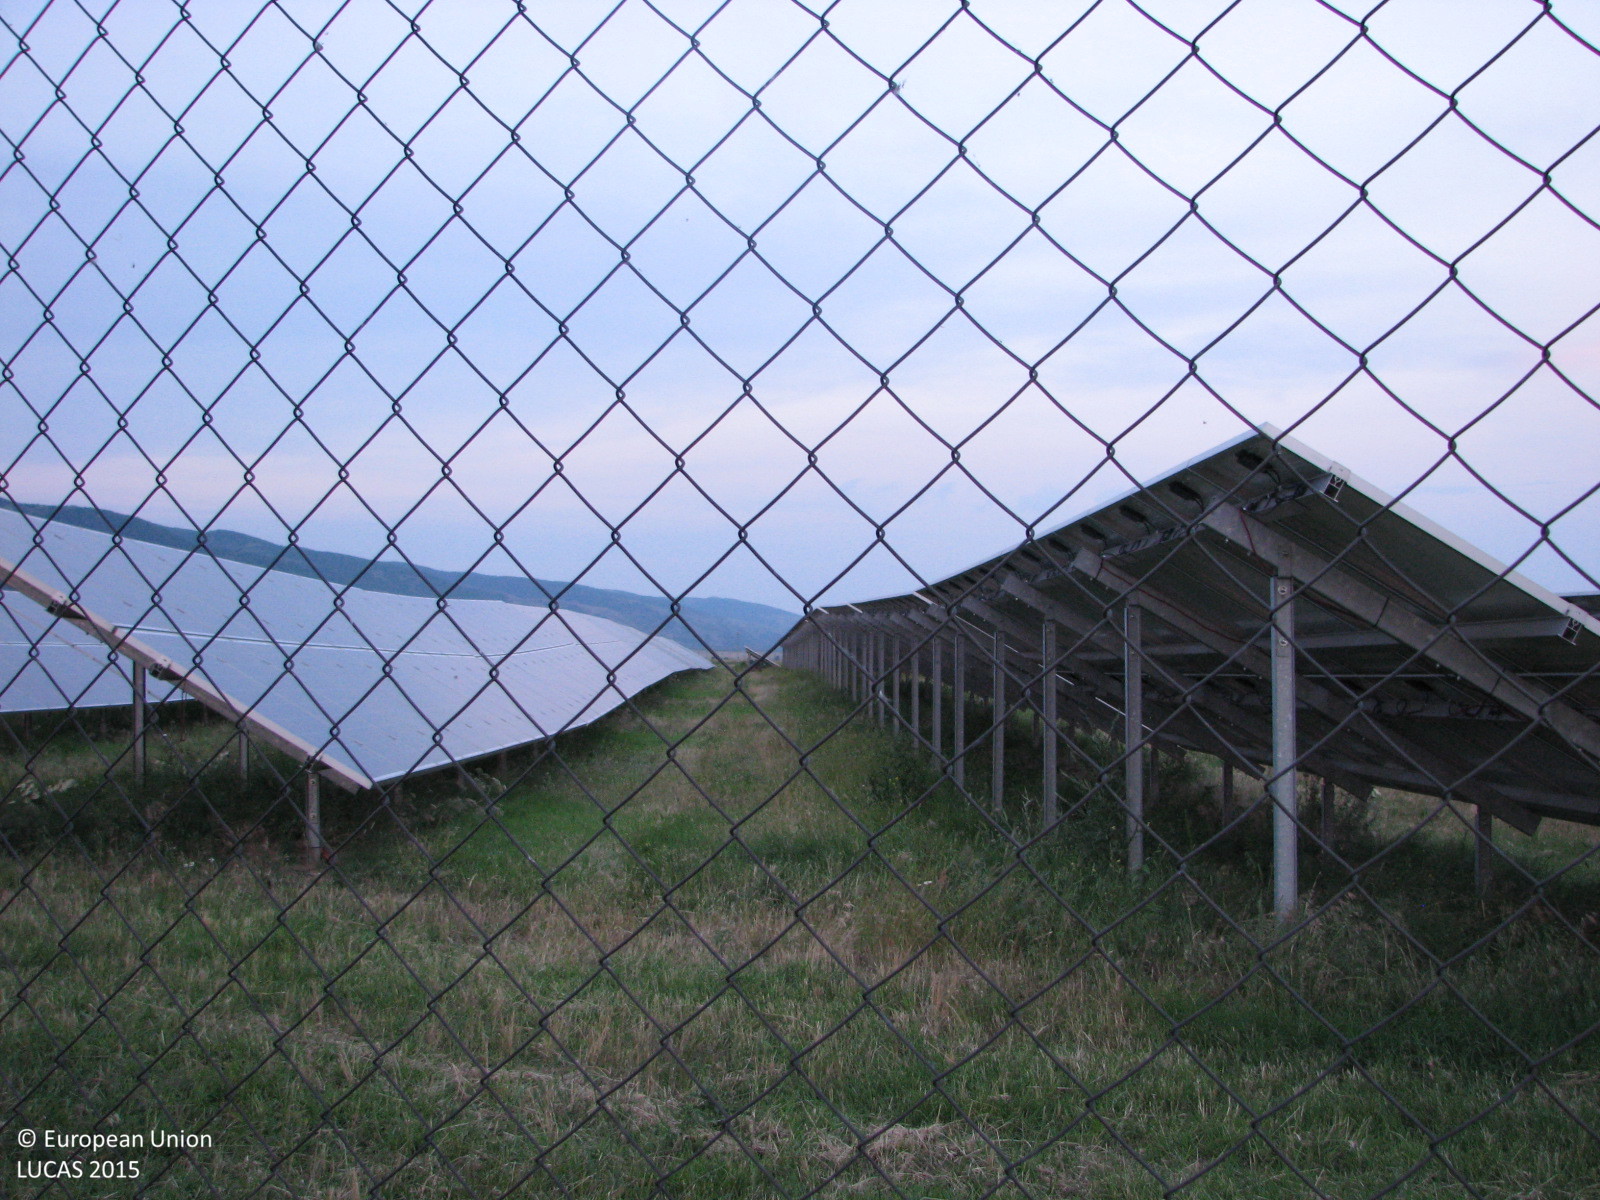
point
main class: Artificial land
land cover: Other artificial areas
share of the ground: 50 - 75 %
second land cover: Spontaneously vegetated surfaces
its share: 25 - 50 %
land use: Energy production
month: June
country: BG
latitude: 42.6665
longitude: 26.4049
